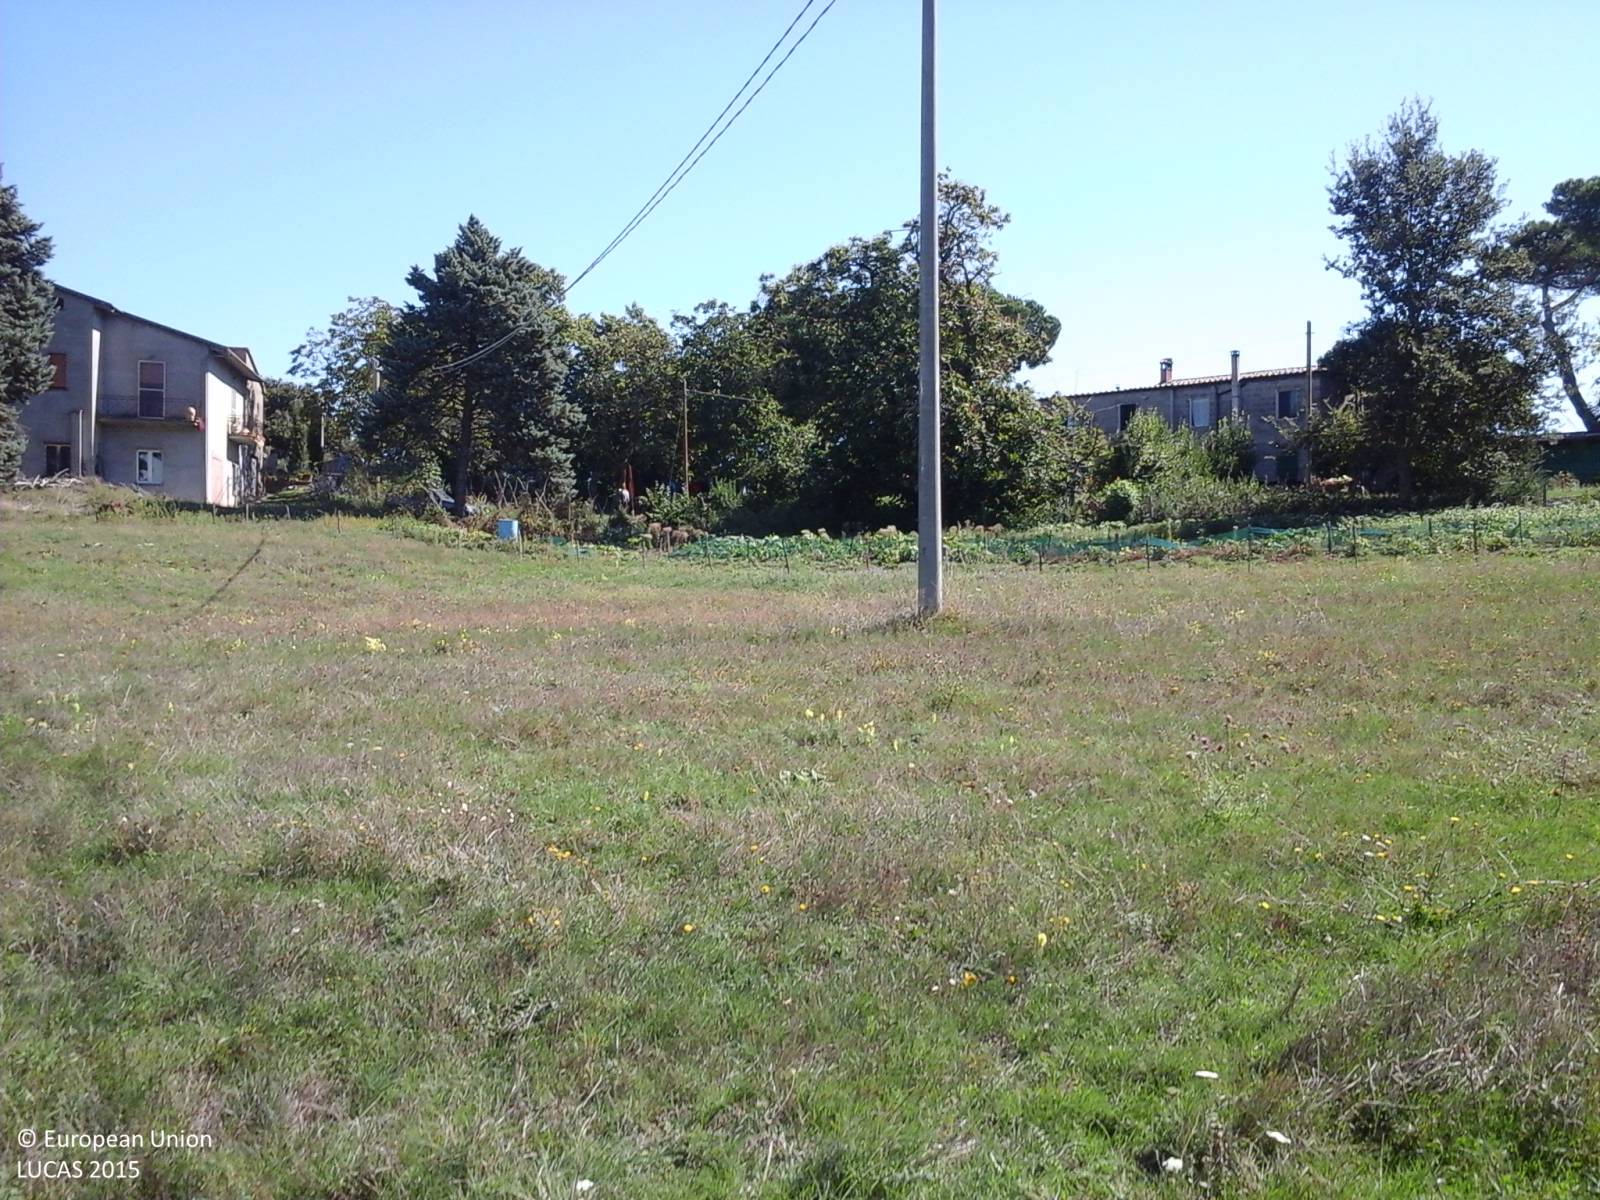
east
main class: Grassland
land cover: Grassland without tree/shrub cover
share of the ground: > 75 %
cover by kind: herbaceous plants 100 %
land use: Agriculture (excluding fallow land and kitchen gardens)
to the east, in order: Grassland without tree/shrub cover; Electric lines; Grassland without tree/shrub cover; Fences; Other non-permanent industrial crops; Broadleaved woodland; Tracks; Fences; Grassland without tree/shrub cover; Lines of trees; Fences; Paved roads, cycling and walking lanes; Grass margins; Fences; Grassland without tree/shrub cover; Artificial constructions in urban areas
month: September
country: IT
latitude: 42.6874
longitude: 12.0560
